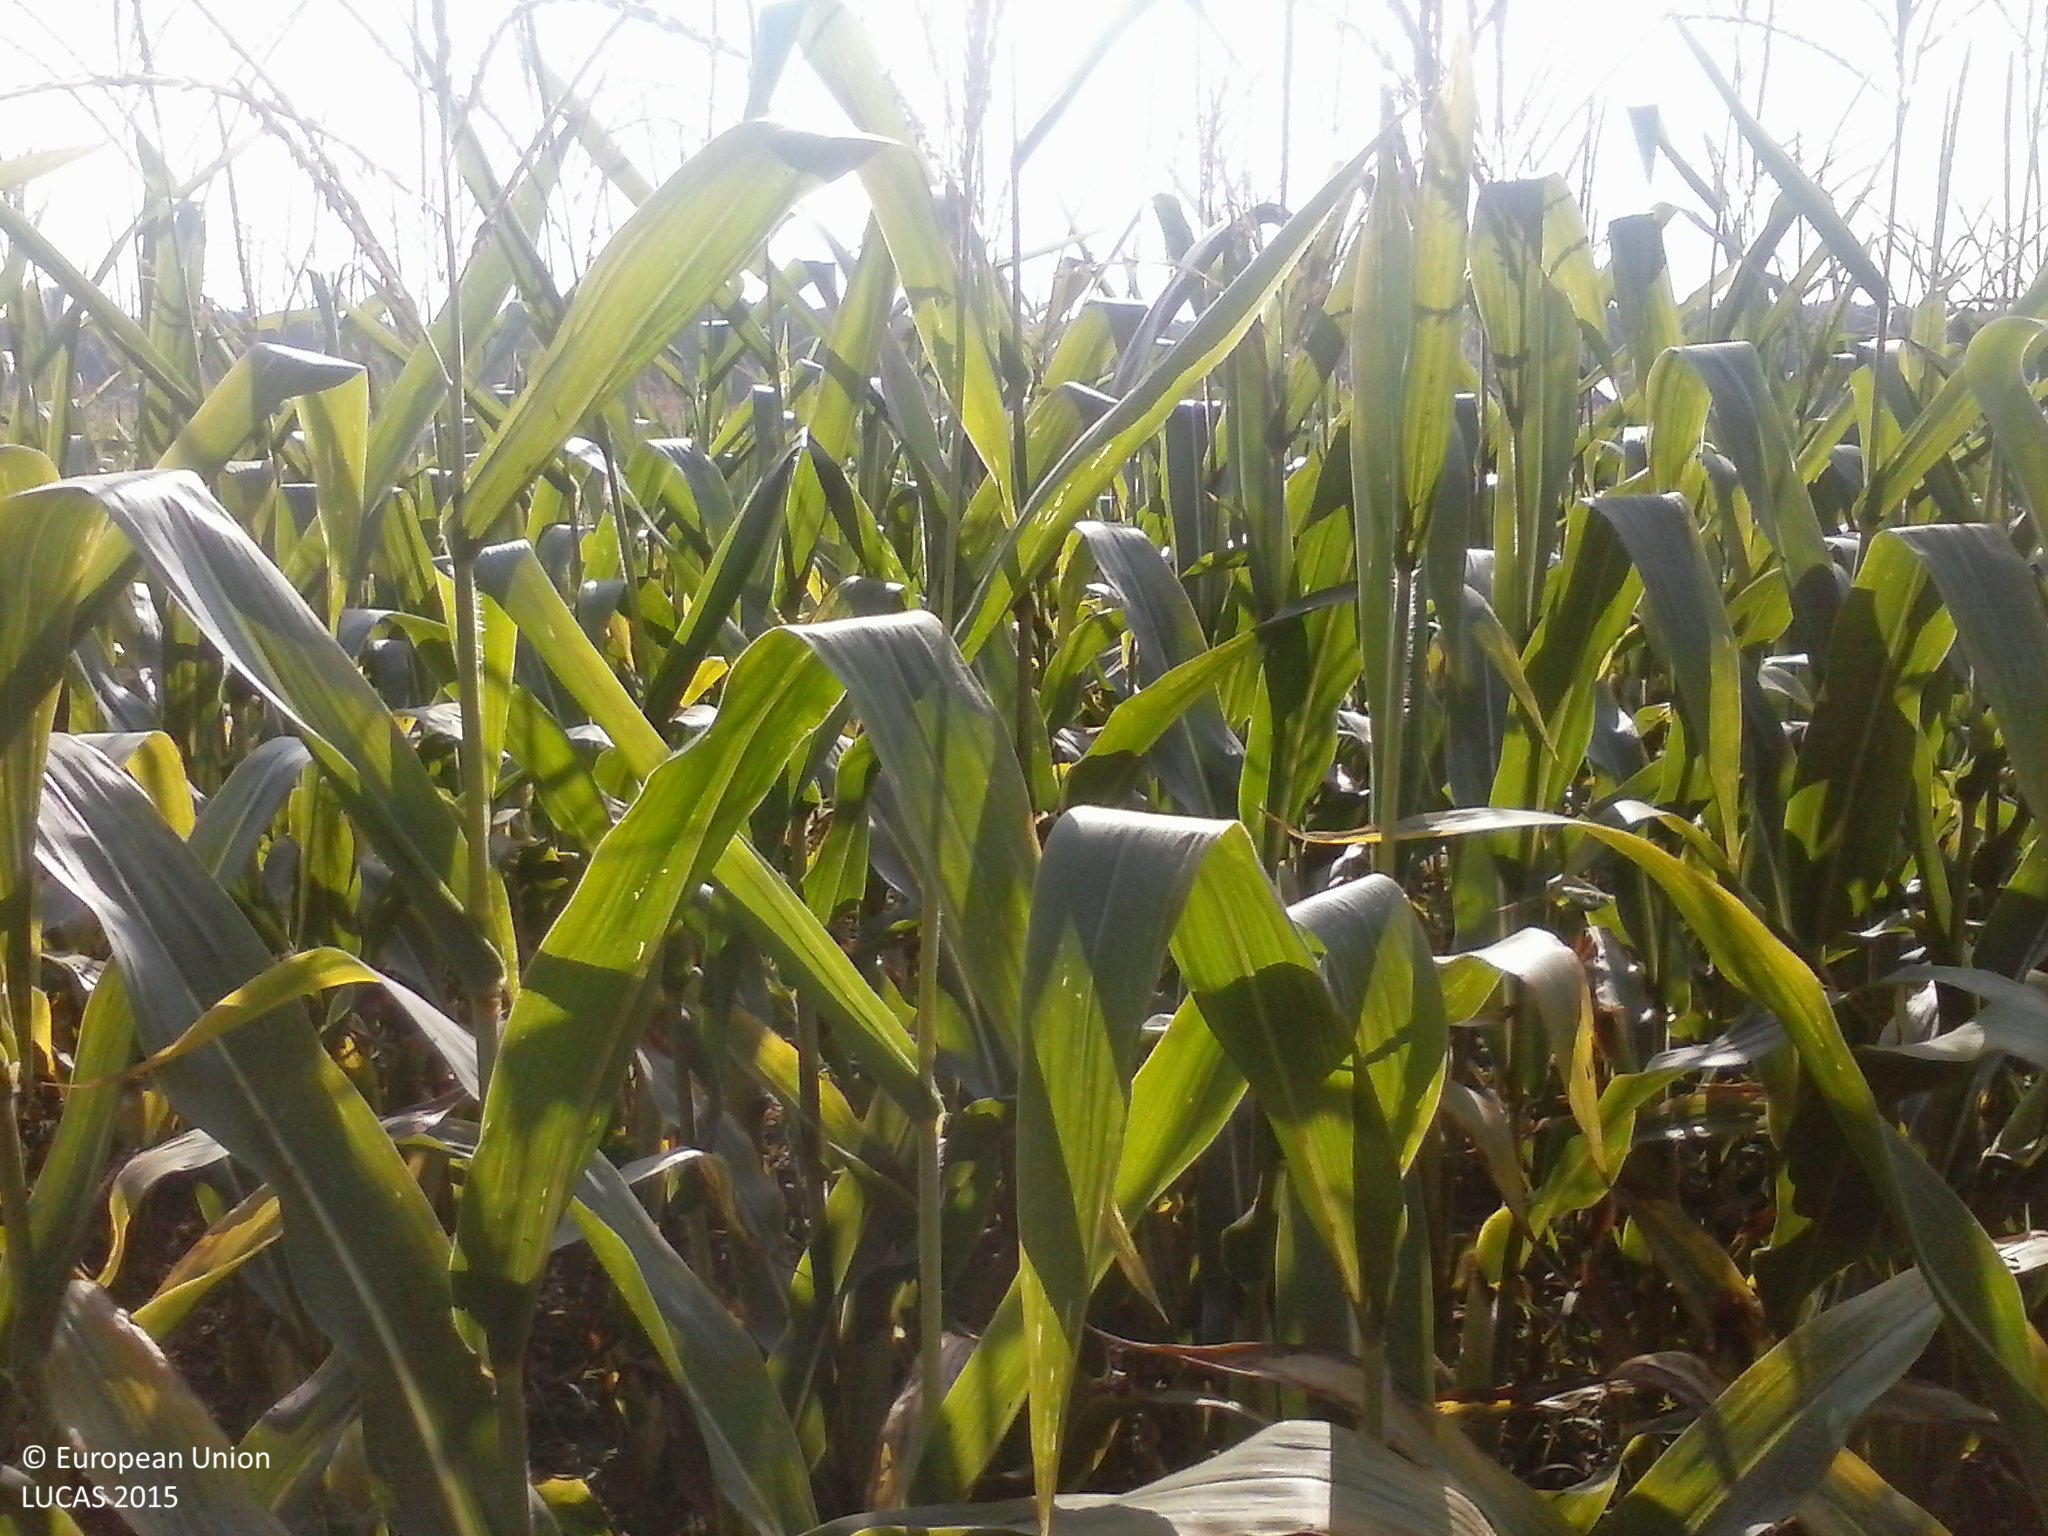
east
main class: Cropland
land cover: Maize
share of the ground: > 75 %
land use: Agriculture (excluding fallow land and kitchen gardens)
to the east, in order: Maize; Lucerne; Grassland without tree/shrub cover; Lucerne
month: August
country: HU
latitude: 45.8955
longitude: 17.9052
